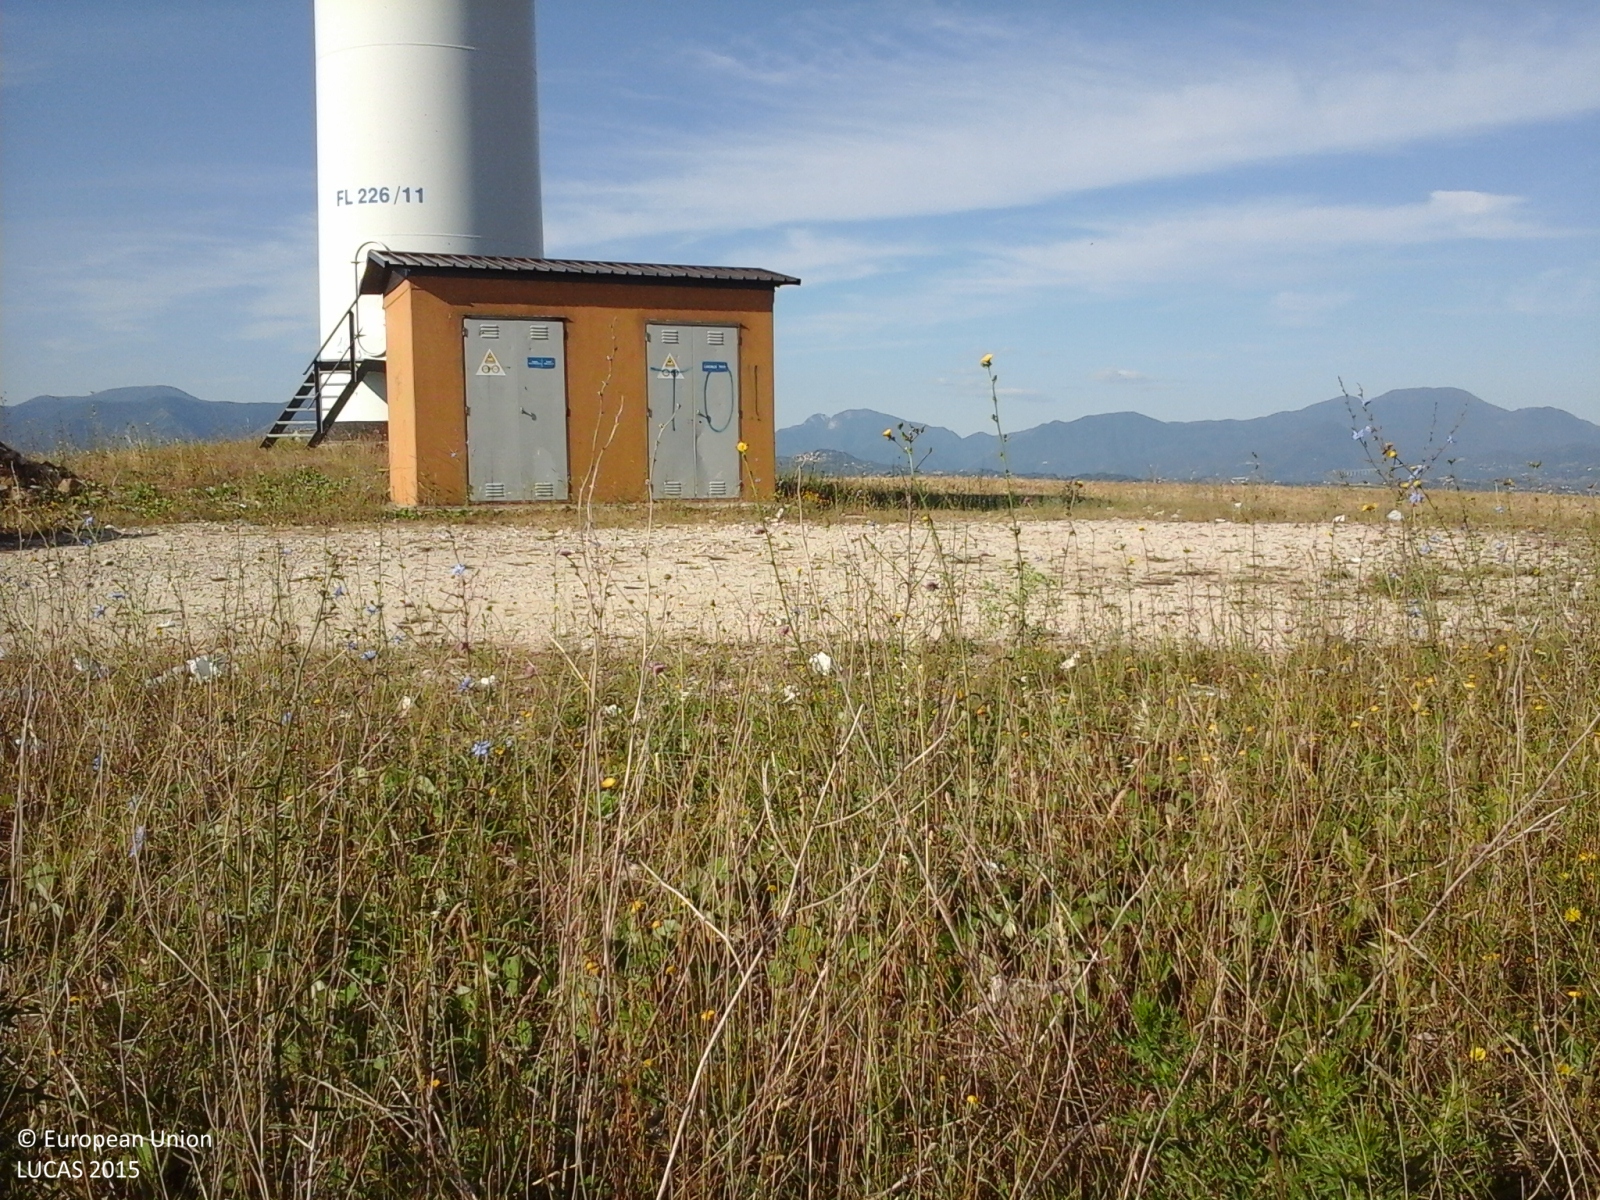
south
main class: Grassland
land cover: Grassland with sparse tree/shrub cover
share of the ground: > 75 %
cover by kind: herbaceous plants 85 %, shrubs 10 %, broadleaved forest trees 5 %
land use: Abandoned areas
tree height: < 5 m
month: June
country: IT
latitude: 40.9840
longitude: 15.1507
